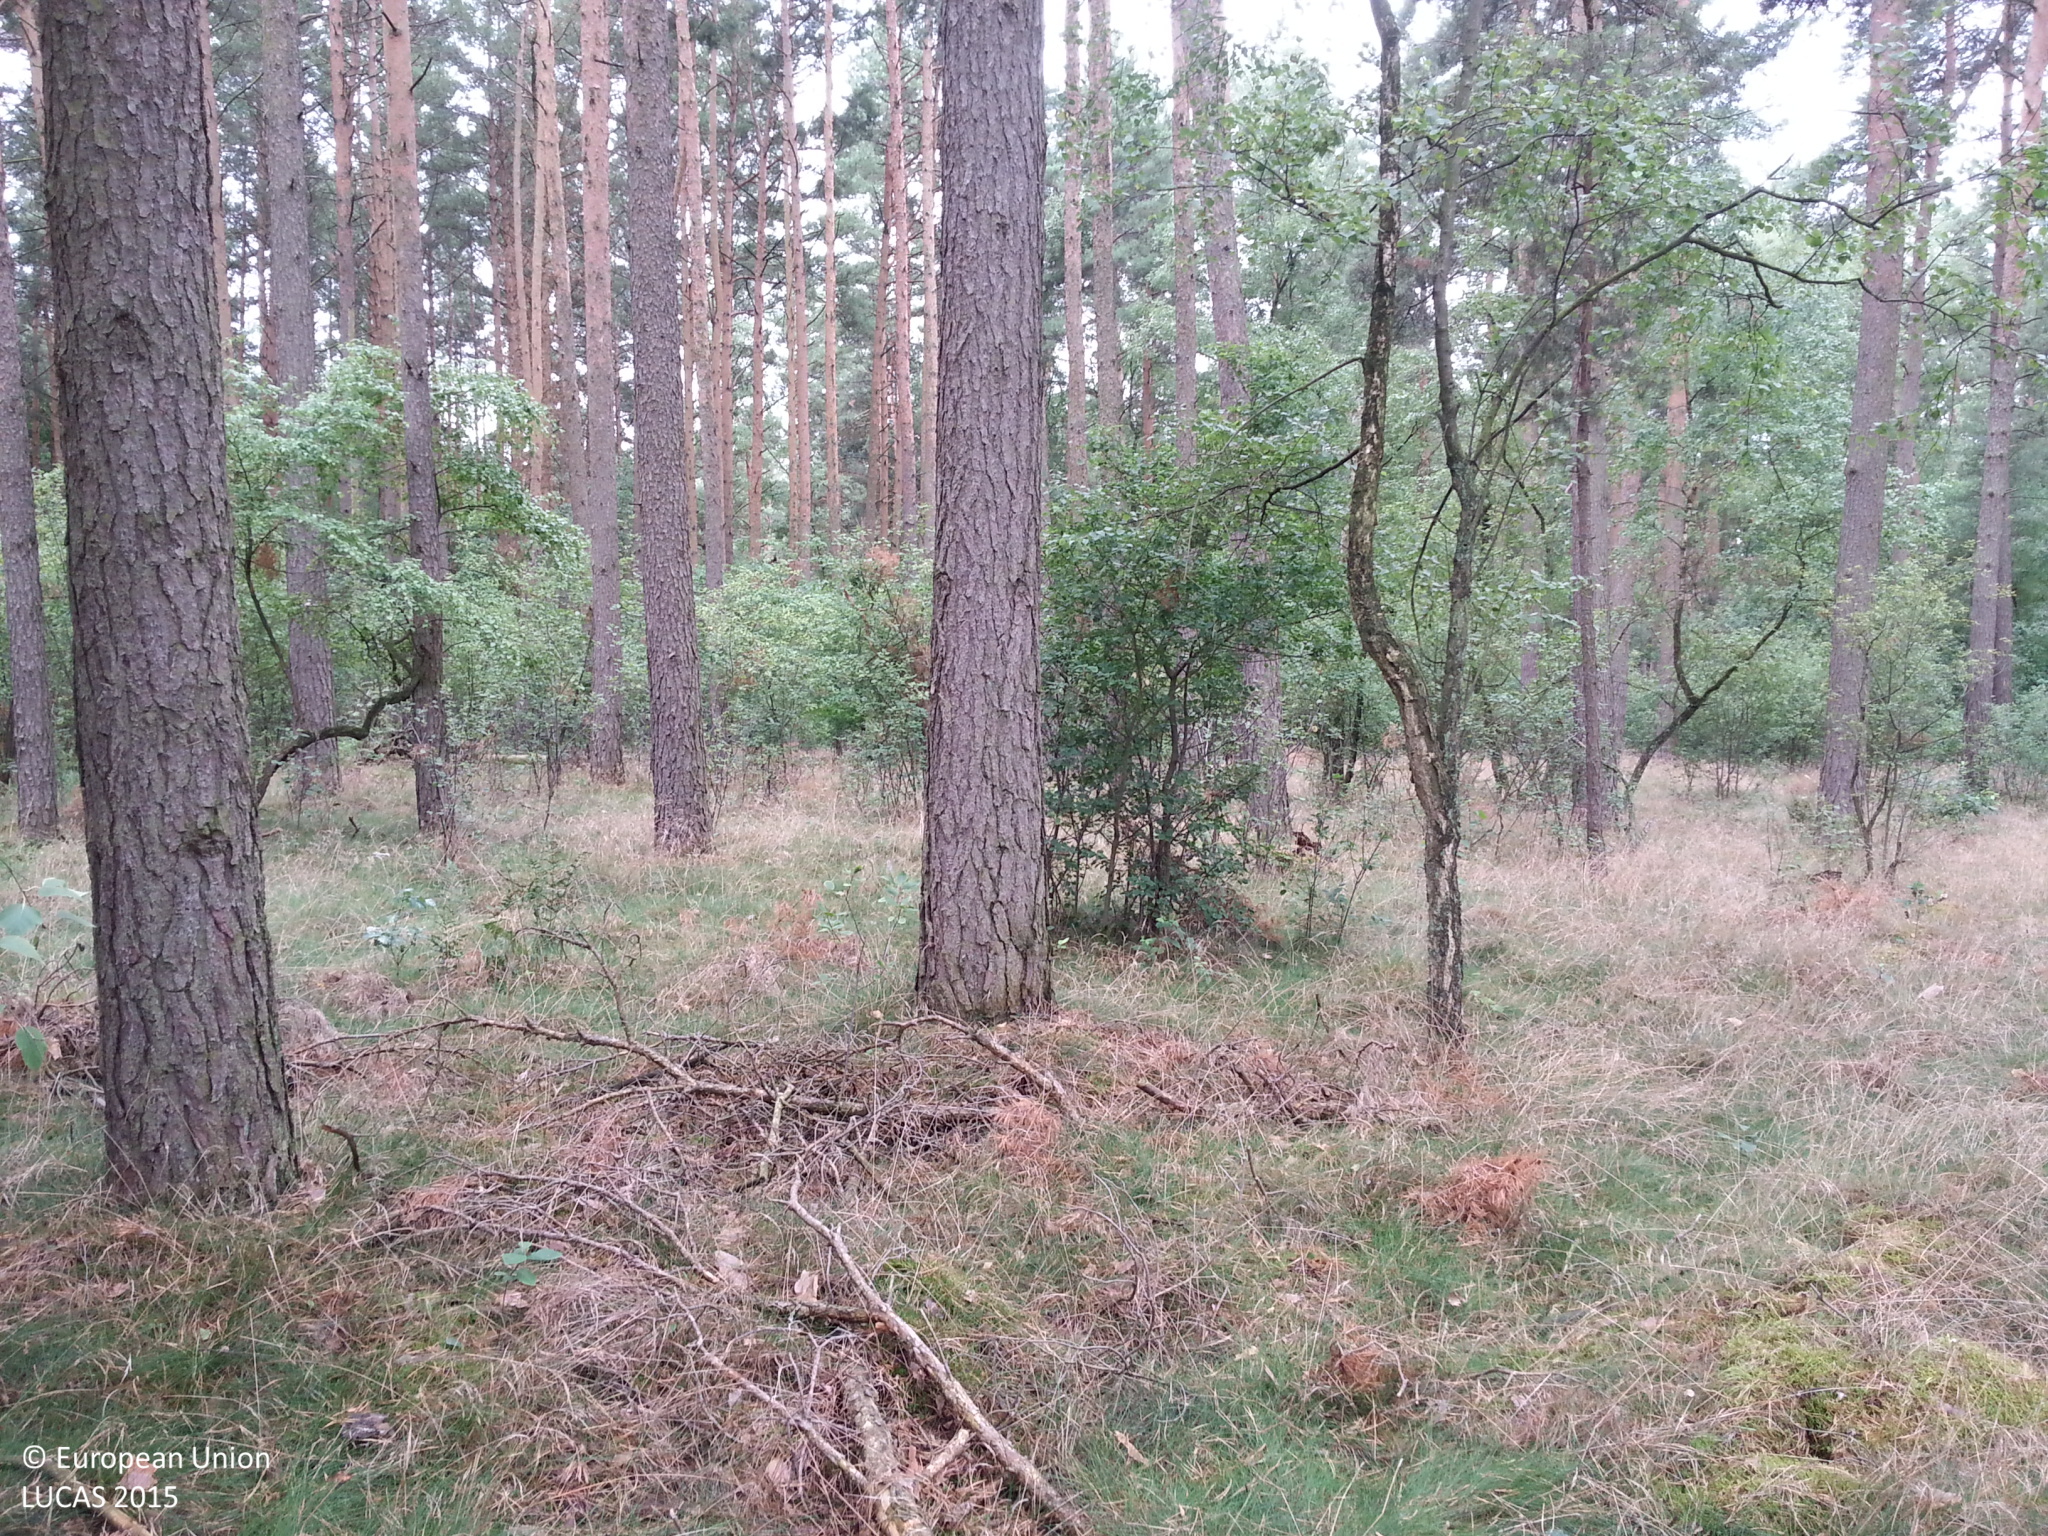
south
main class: Woodland
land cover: Pine dominated coniferous woodland
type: boreal forest
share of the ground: 50 - 75 %
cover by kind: coniferous forest trees 50 %, herbaceous plants 30 %, shrubs 15 %, lichens and mosses 5 %
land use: Forestry
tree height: > 5 m
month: July
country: DE
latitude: 53.0377
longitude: 12.3409
